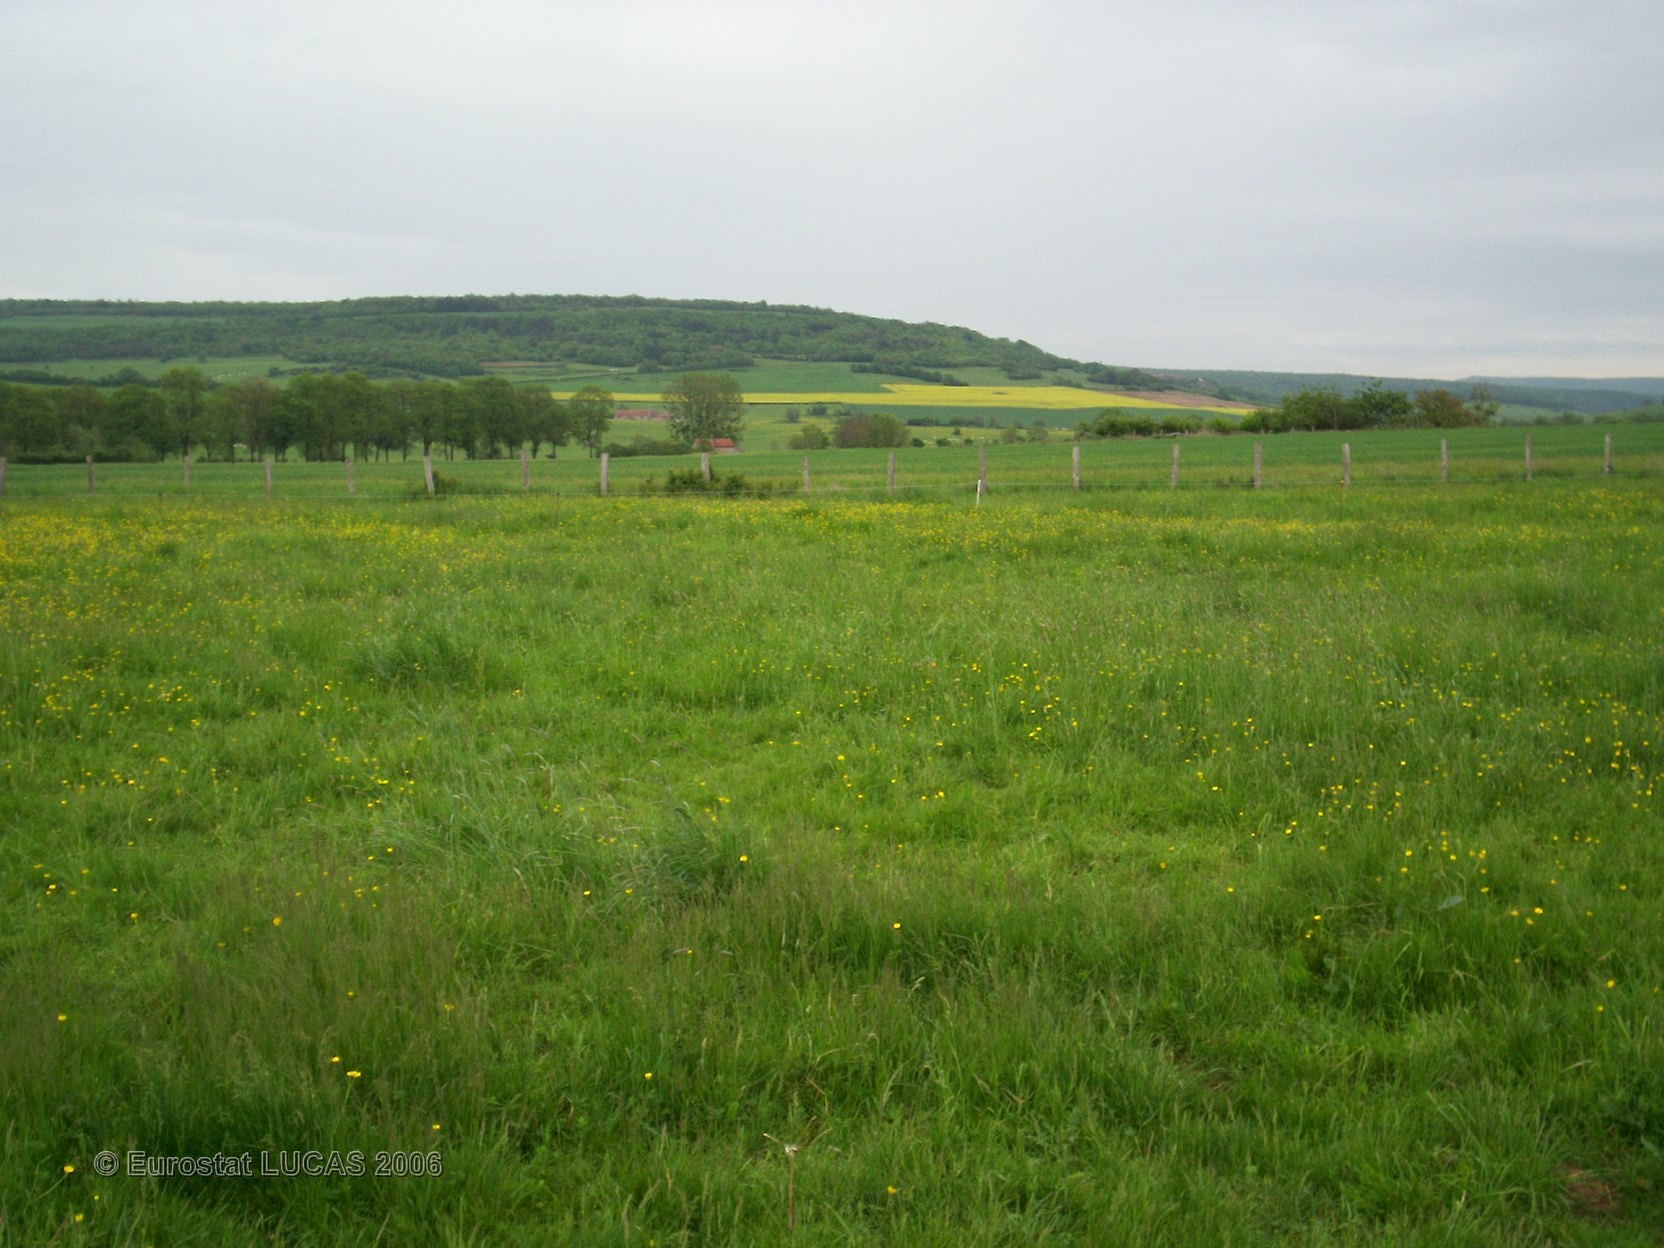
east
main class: Grassland
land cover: Grassland without tree/shrub cover
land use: Agriculture (excluding fallow land and kitchen gardens)
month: May
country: FR
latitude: 47.2087
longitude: 4.6265
